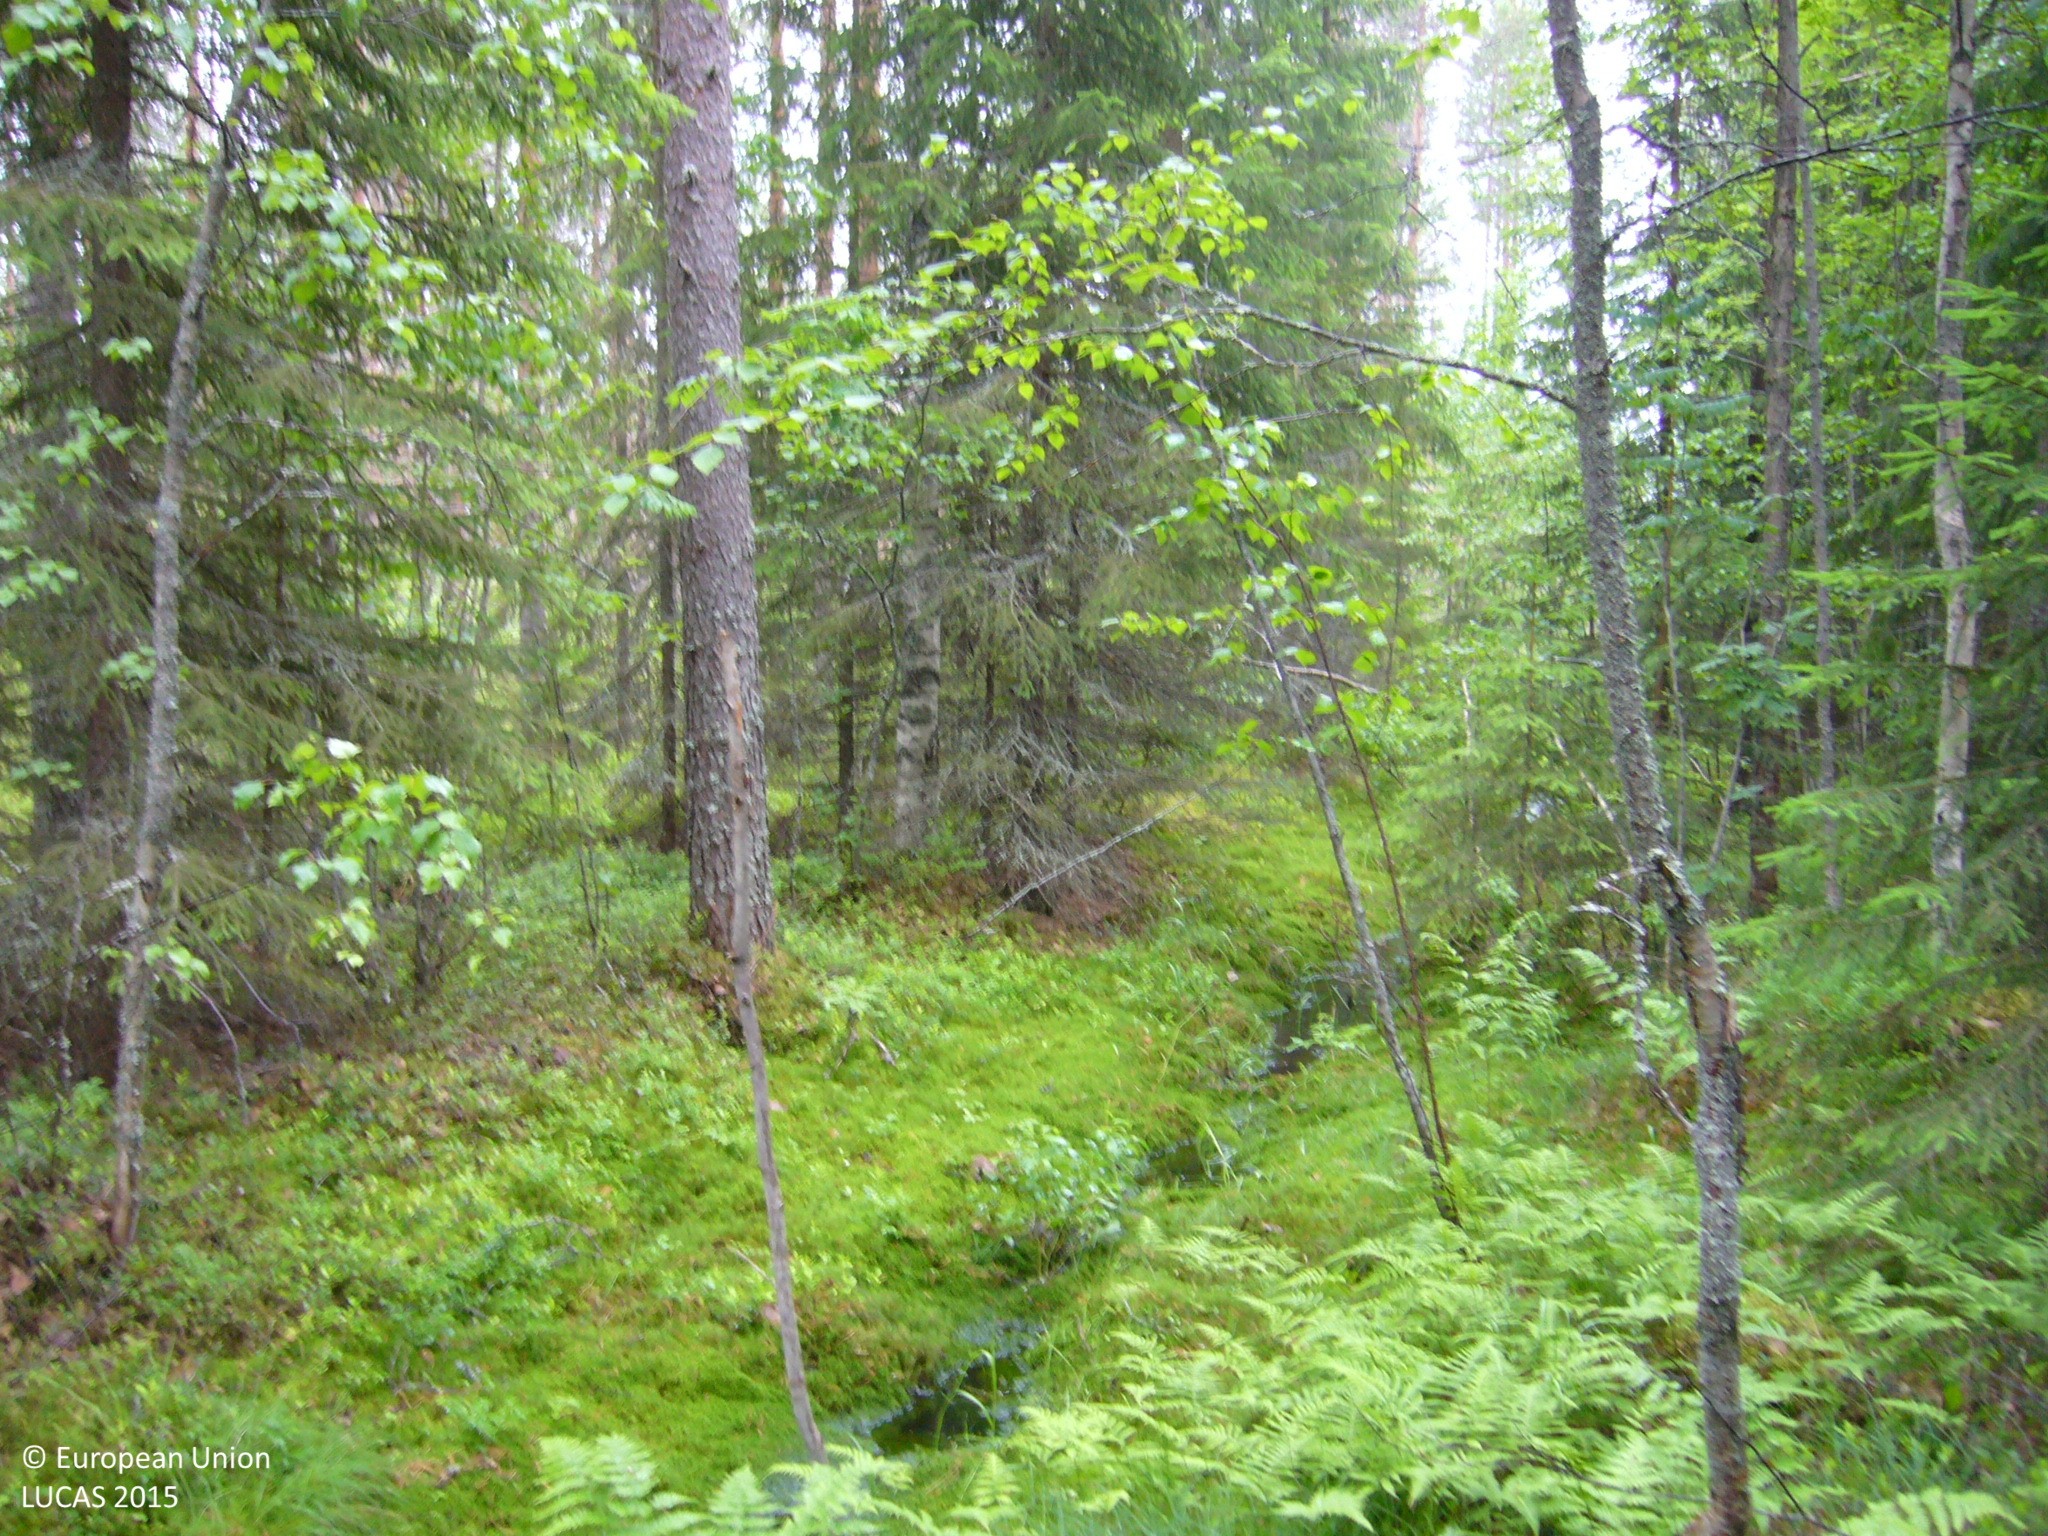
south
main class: Woodland
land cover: Pine dominated mixed woodland
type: boreal forest
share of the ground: > 75 %
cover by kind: coniferous forest trees 50 %, broadleaved forest trees 25 %, shrubs 25 %
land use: Forestry
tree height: > 5 m
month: July
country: FI
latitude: 63.4275
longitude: 26.3741
